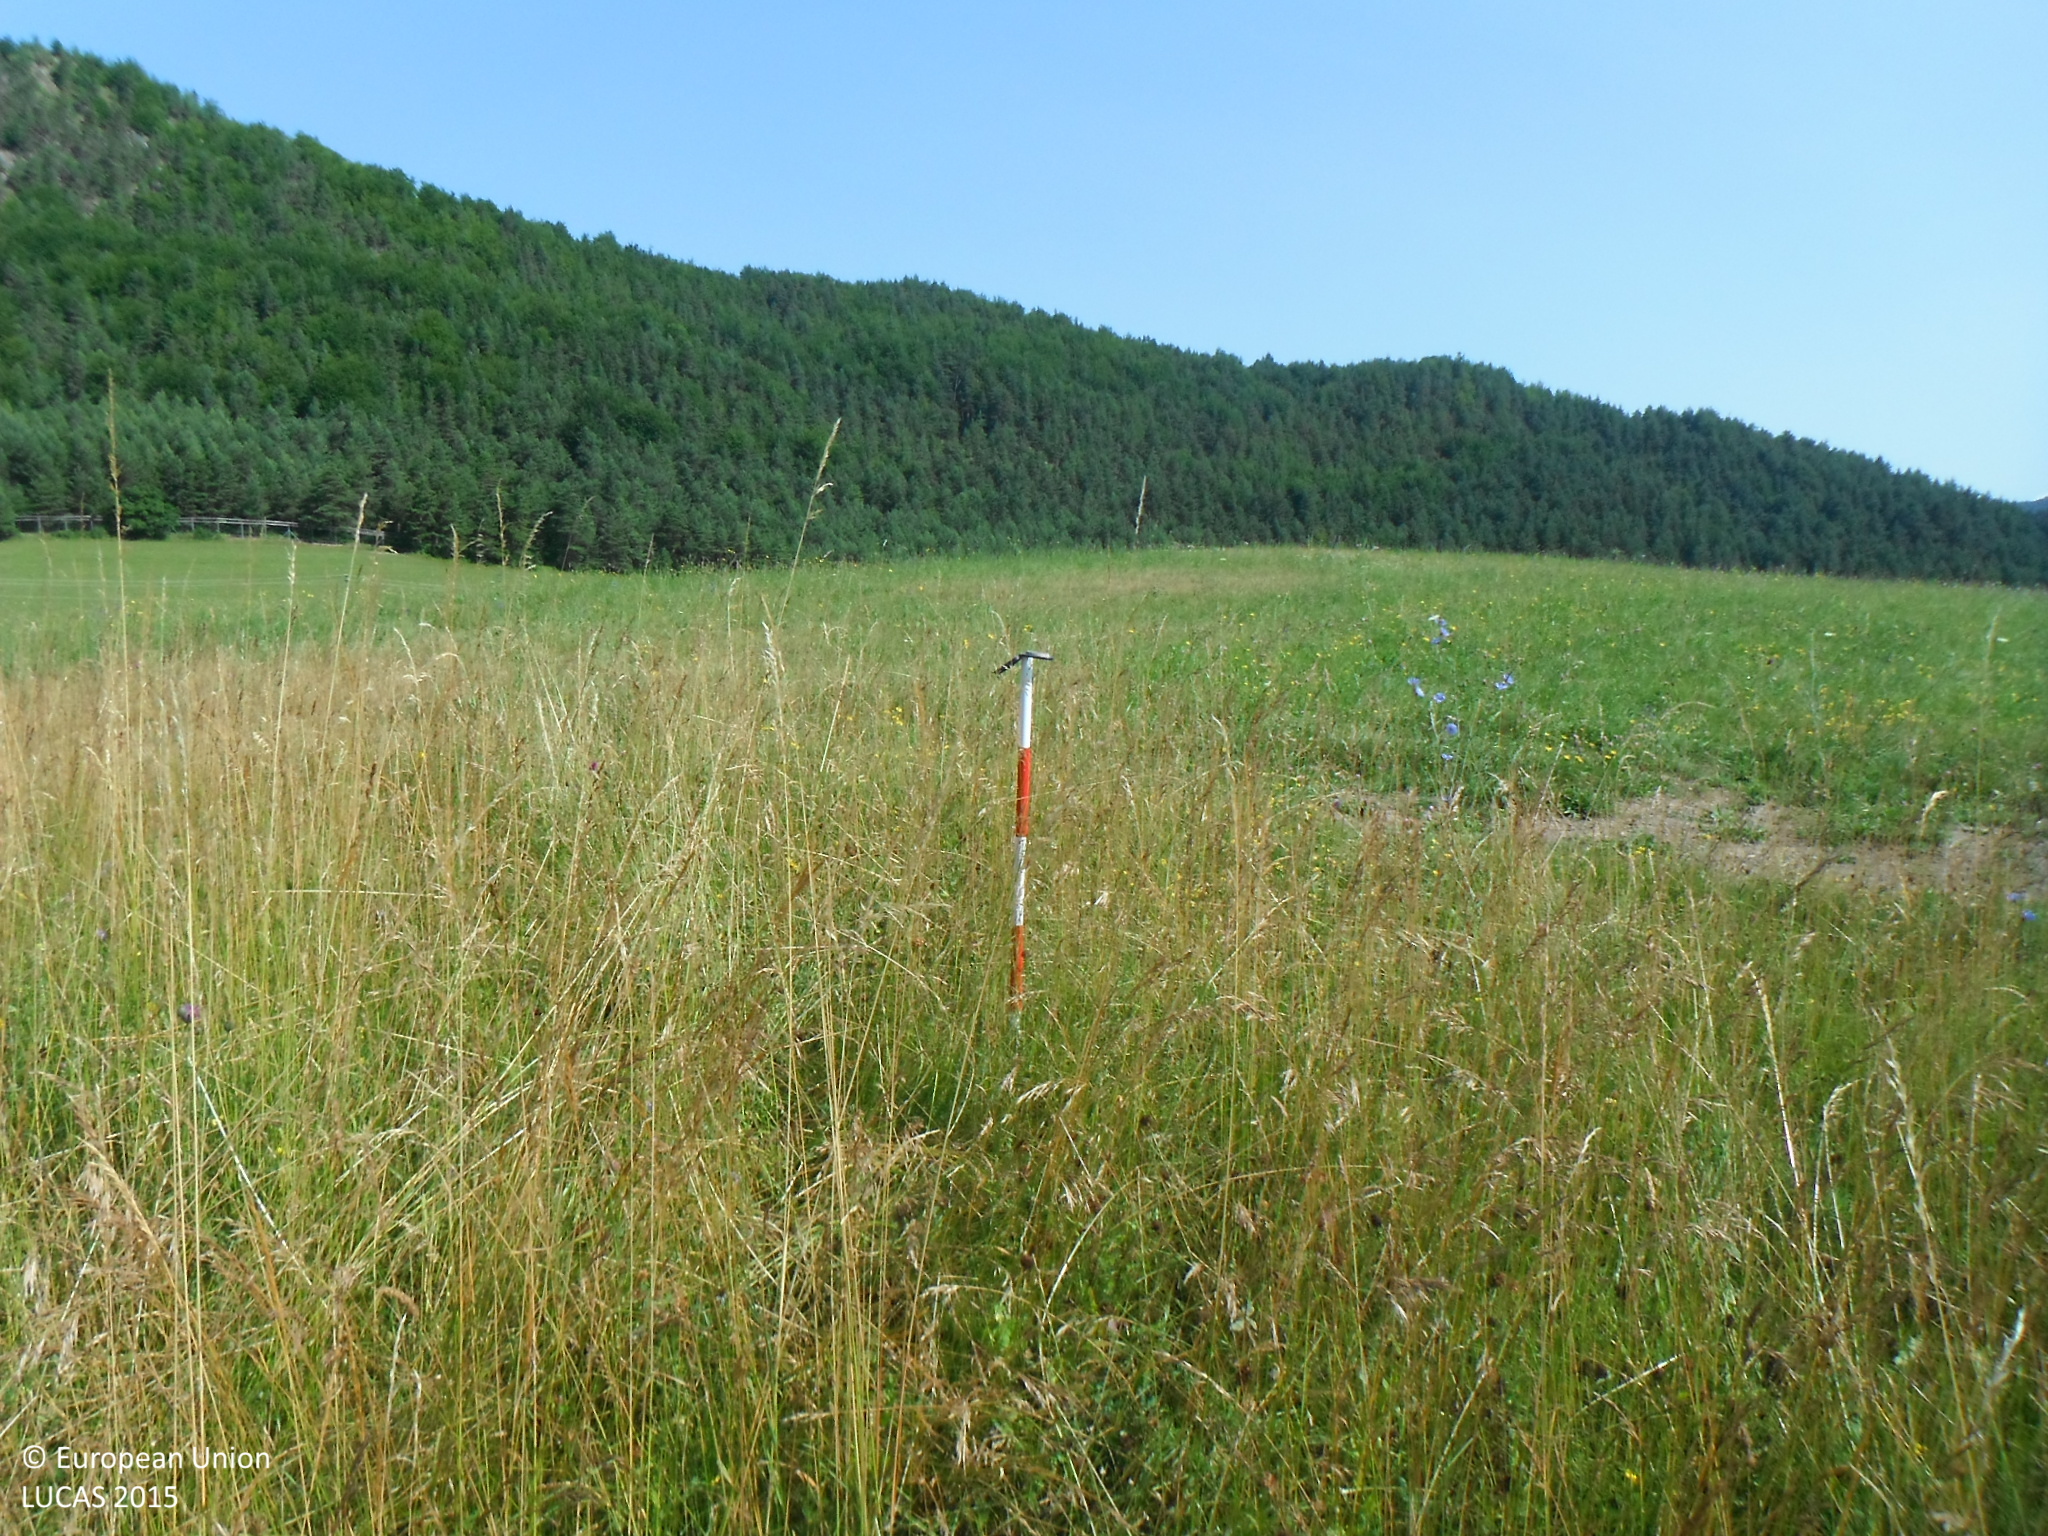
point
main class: Grassland
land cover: Grassland without tree/shrub cover
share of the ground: > 75 %
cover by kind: herbaceous plants 100 %
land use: Agriculture (excluding fallow land and kitchen gardens)
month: July
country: SK
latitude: 49.0199
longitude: 18.4545
